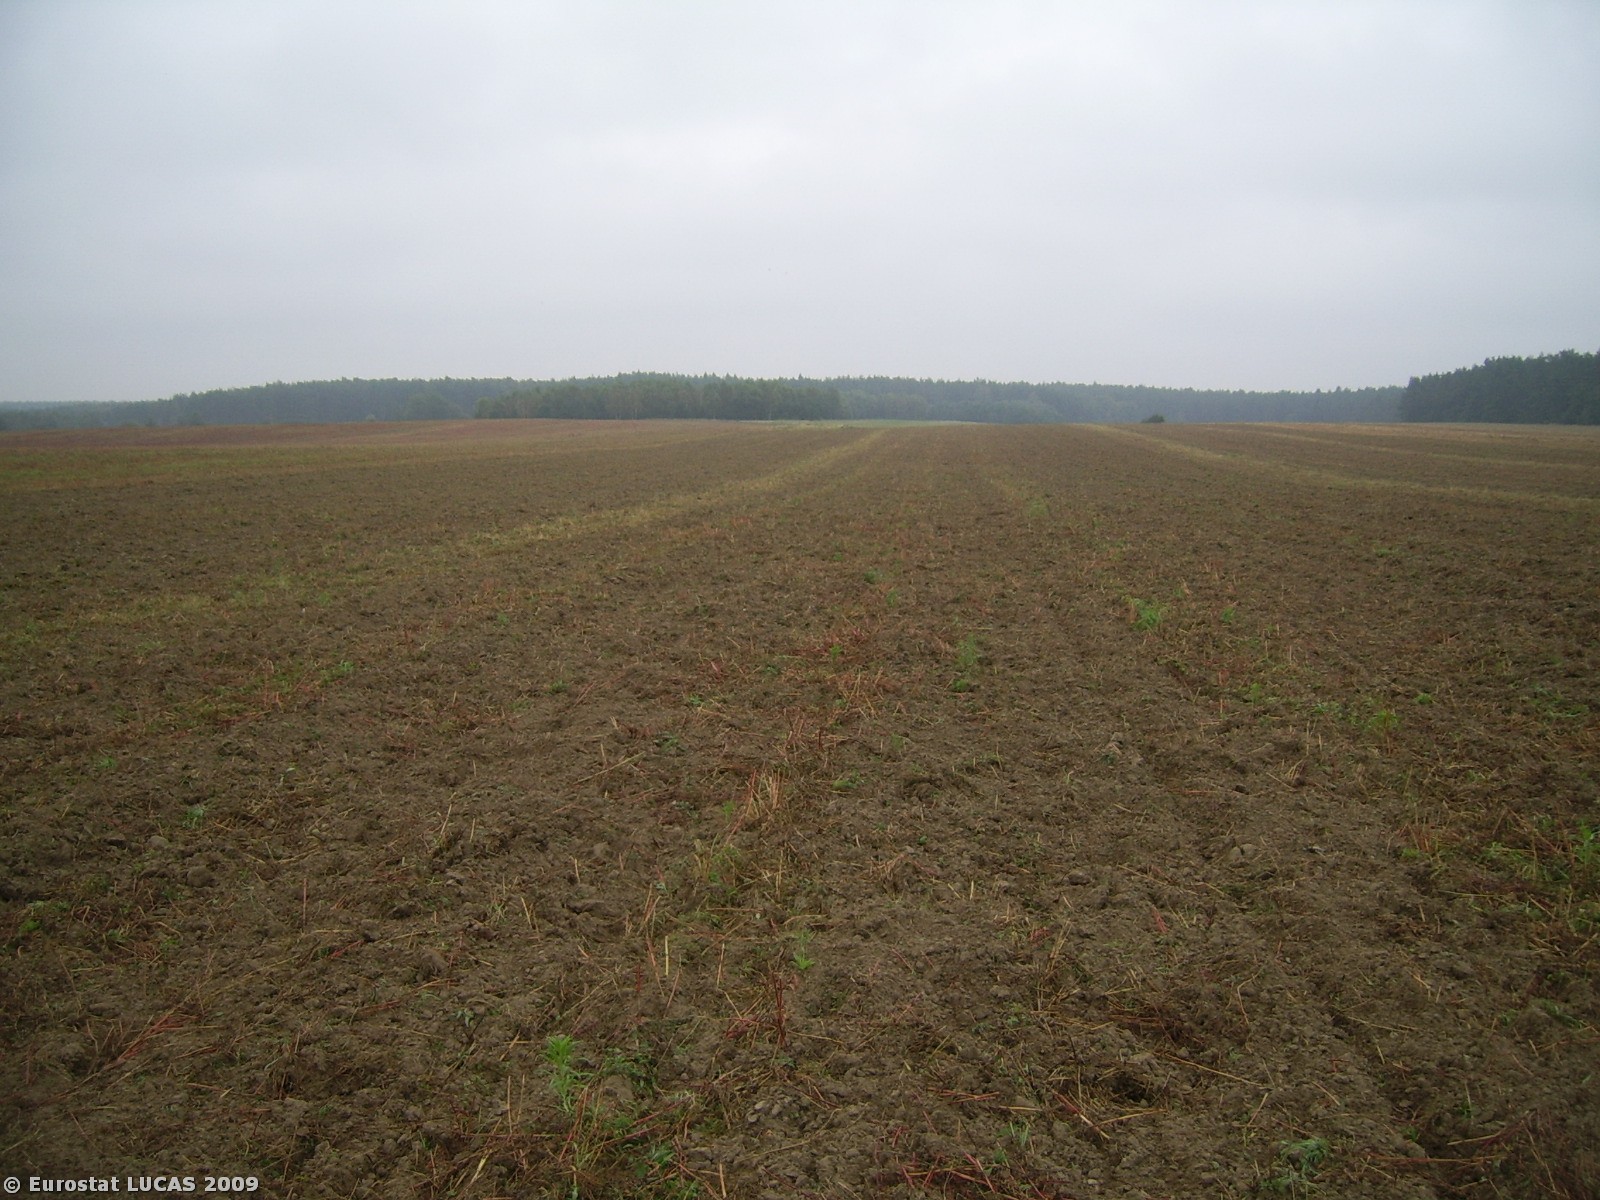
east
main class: Cropland
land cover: Other cereals
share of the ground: < 10 %
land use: Agriculture (excluding fallow land and kitchen gardens)
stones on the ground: < 10 %
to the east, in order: Other cereals
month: September
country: PL
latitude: 54.1870
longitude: 16.4267
